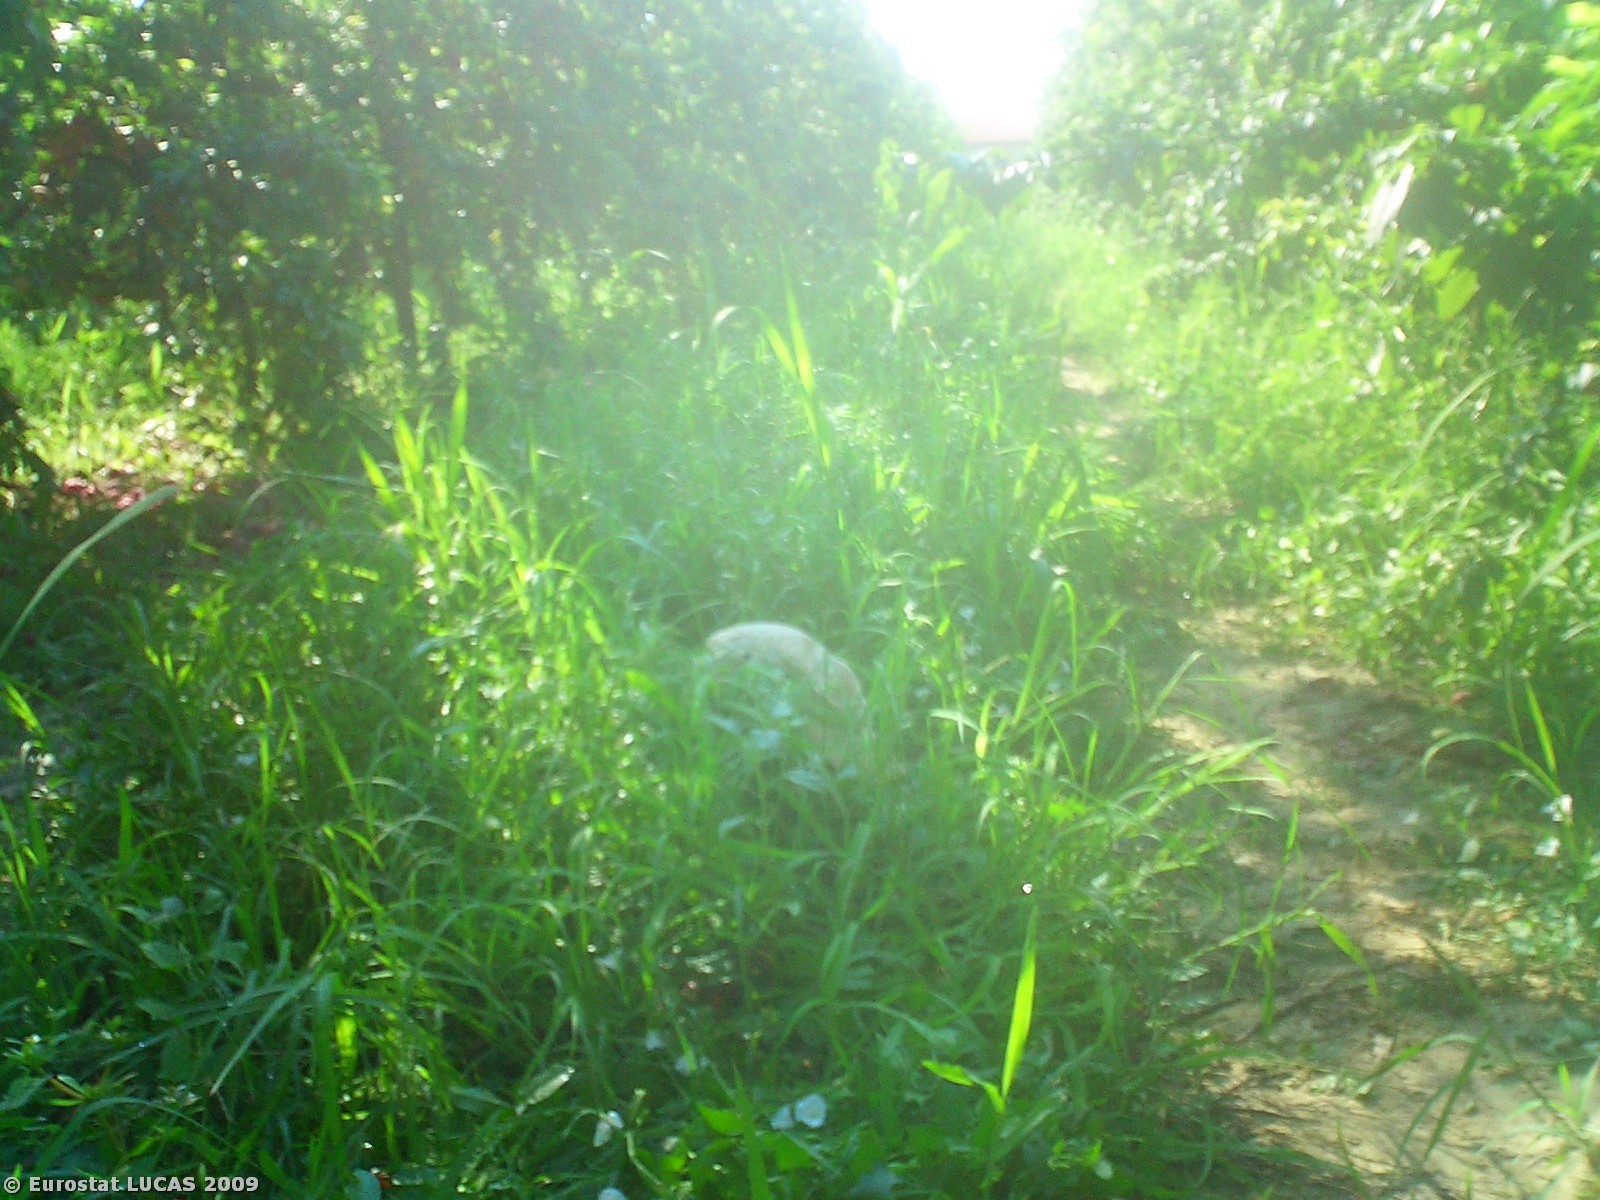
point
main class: Cropland
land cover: Other fruit trees and berries
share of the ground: 50 - 75 %
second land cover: Grassland with sparse tree/shrub cover
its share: 50 - 75 %
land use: Agriculture (excluding fallow land and kitchen gardens)
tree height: < 5 m
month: July
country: IT
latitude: 44.3320
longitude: 11.9646
